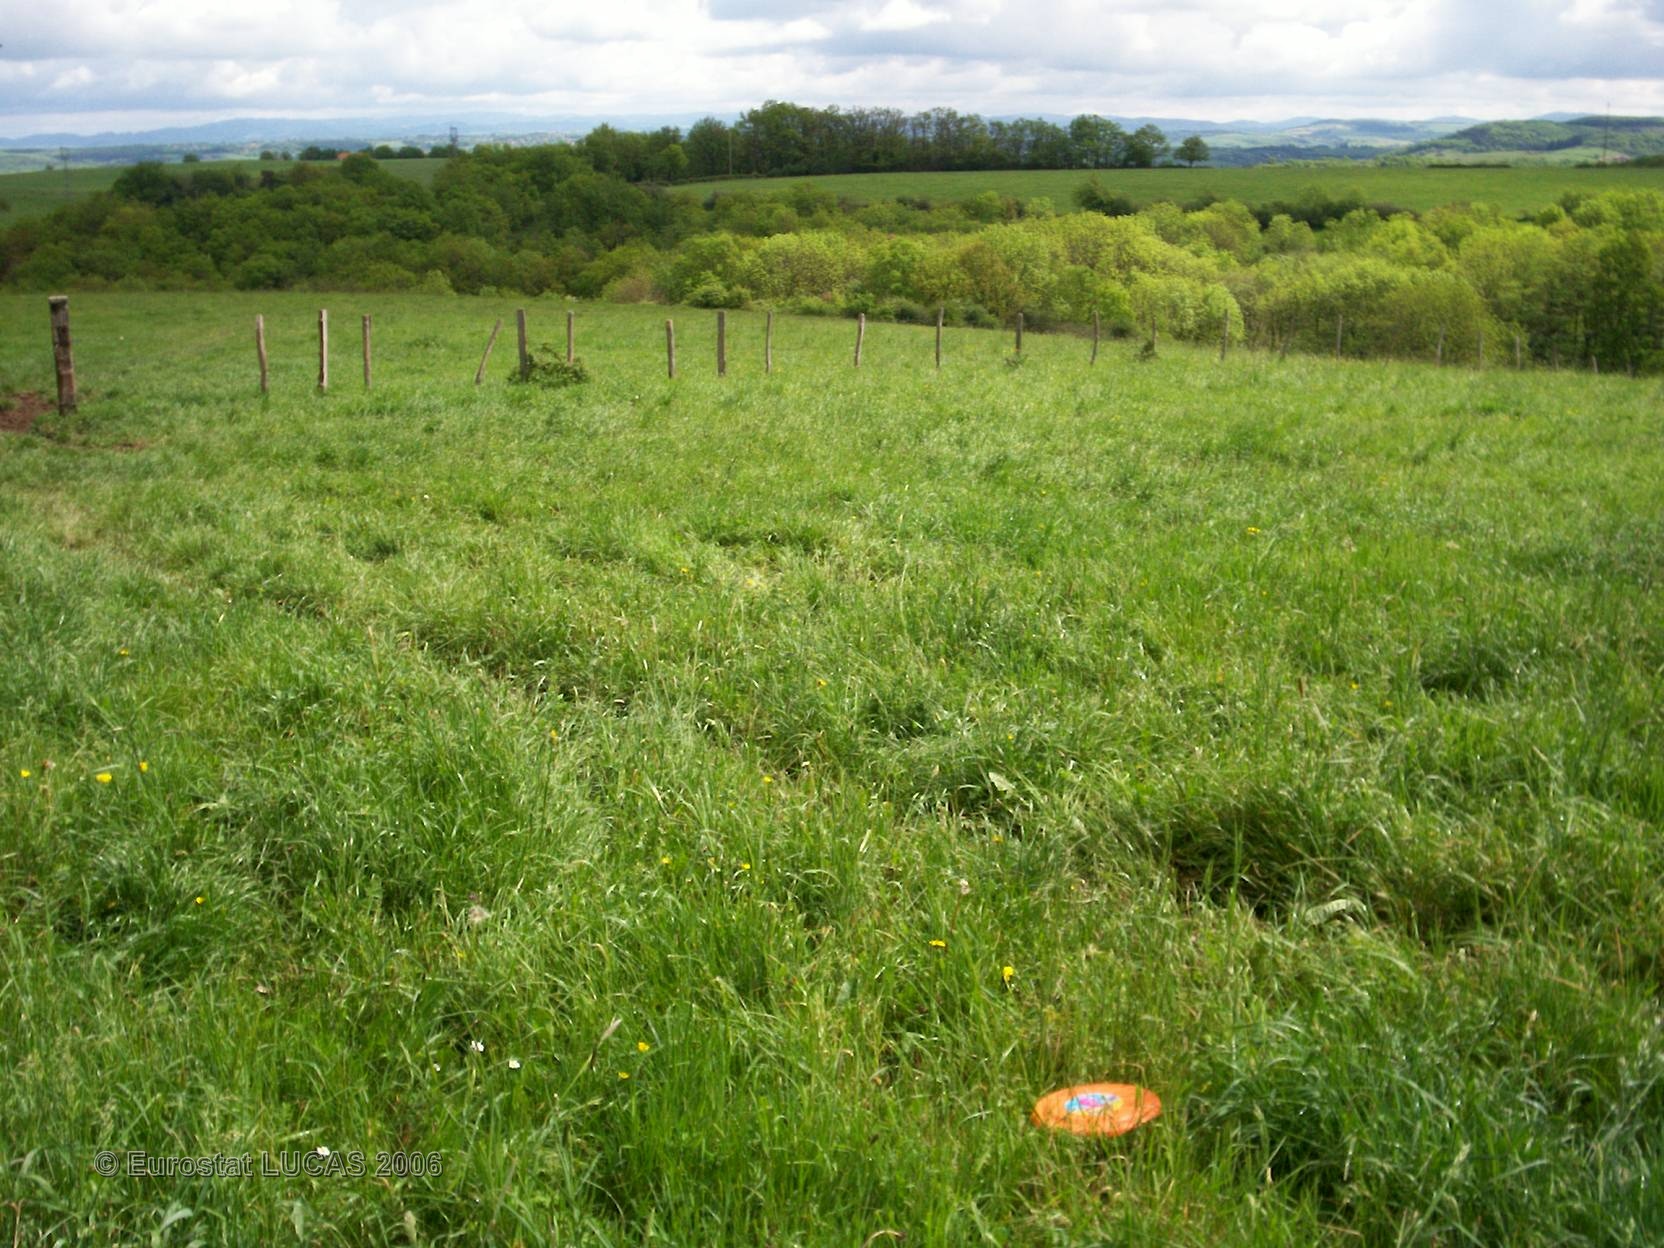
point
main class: Grassland
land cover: Grassland without tree/shrub cover
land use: Agriculture (excluding fallow land and kitchen gardens)
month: May
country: FR
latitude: 45.9539
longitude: 4.1058
